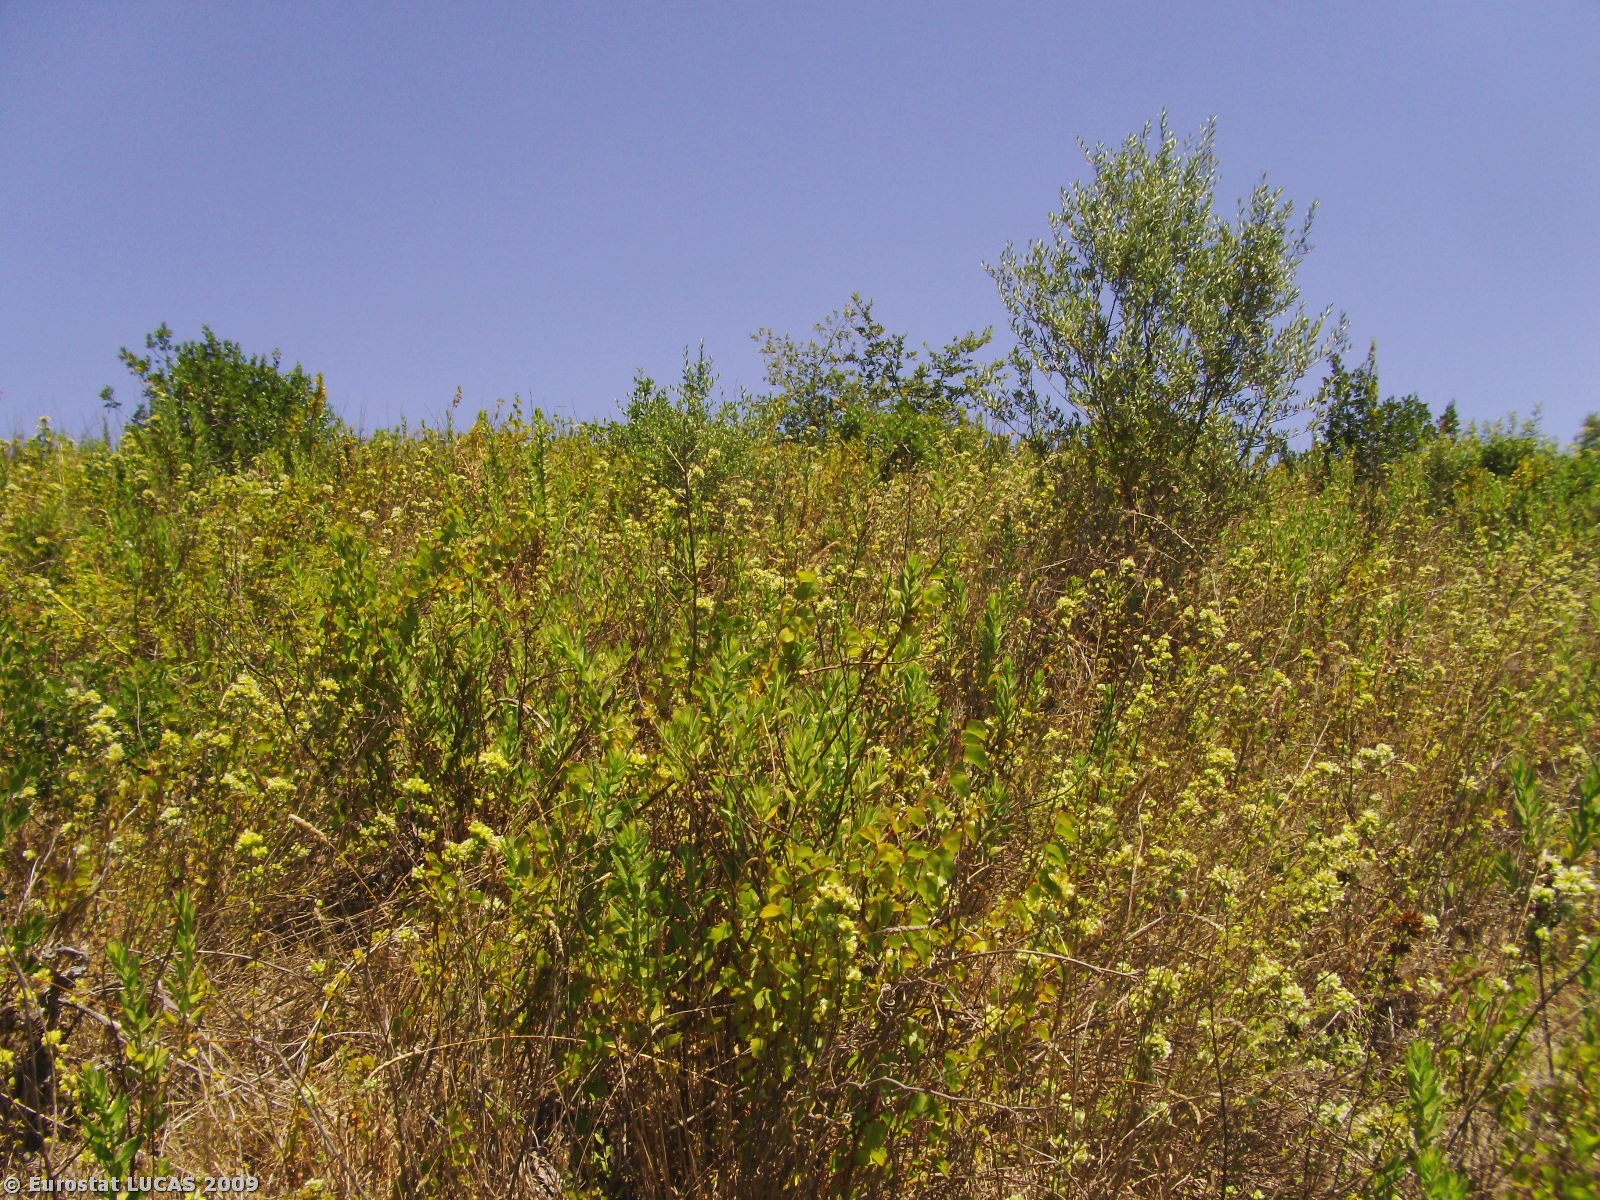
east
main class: Shrubland
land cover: Shrubland without tree cover
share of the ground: > 75 %
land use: Unused
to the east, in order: Shrubland without tree cover; Tracks; Spontaneously vegetated surfaces; Olive groves; Paved roads, cycling and walking lanes; Electric lines; Other fruit trees and berries; Other structural elements; Other fruit trees and berries; Apple fruit; Spontaneously vegetated surfaces; Tracks; Vineyards; Tracks
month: July
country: PT
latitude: 39.0851
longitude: -9.0509
